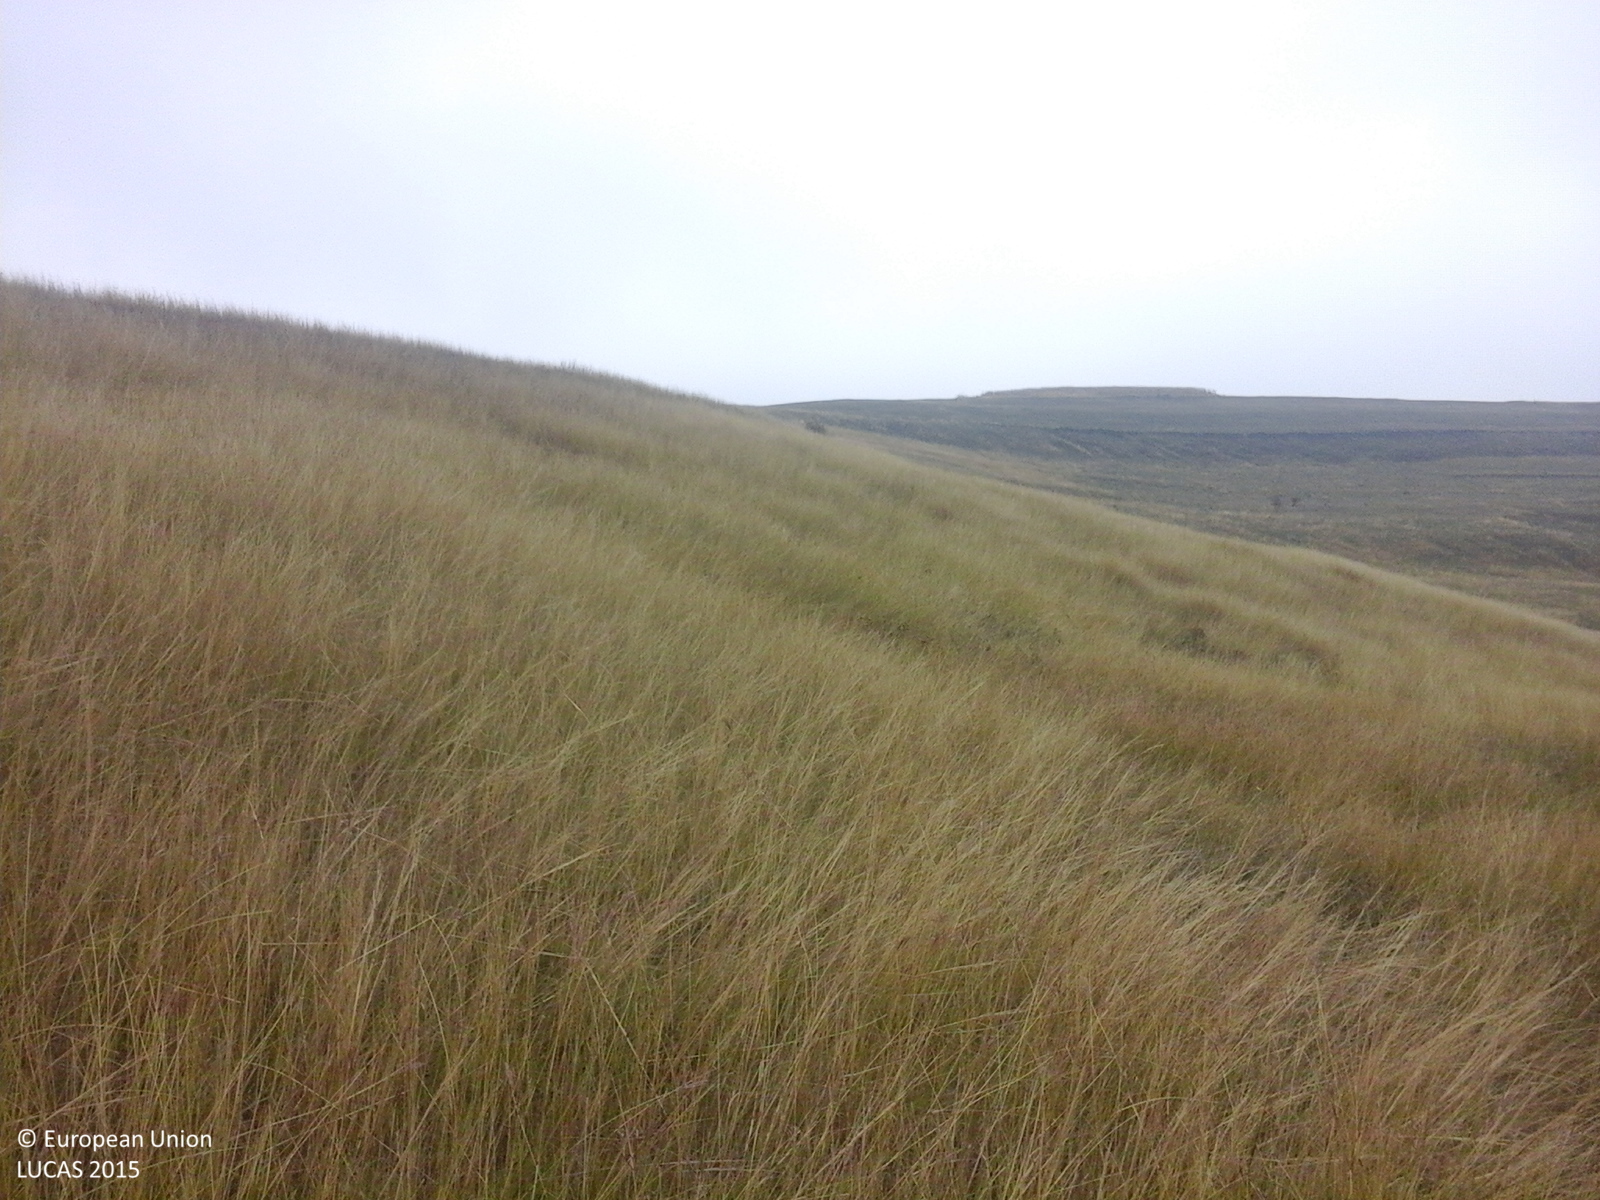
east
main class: Grassland
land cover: Grassland without tree/shrub cover
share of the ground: > 75 %
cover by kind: herbaceous plants 100 %
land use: Agriculture (excluding fallow land and kitchen gardens)
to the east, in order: Grassland without tree/shrub cover; Grassland with sparse tree/shrub cover
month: October
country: RO
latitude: 46.0539
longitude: 23.9413
